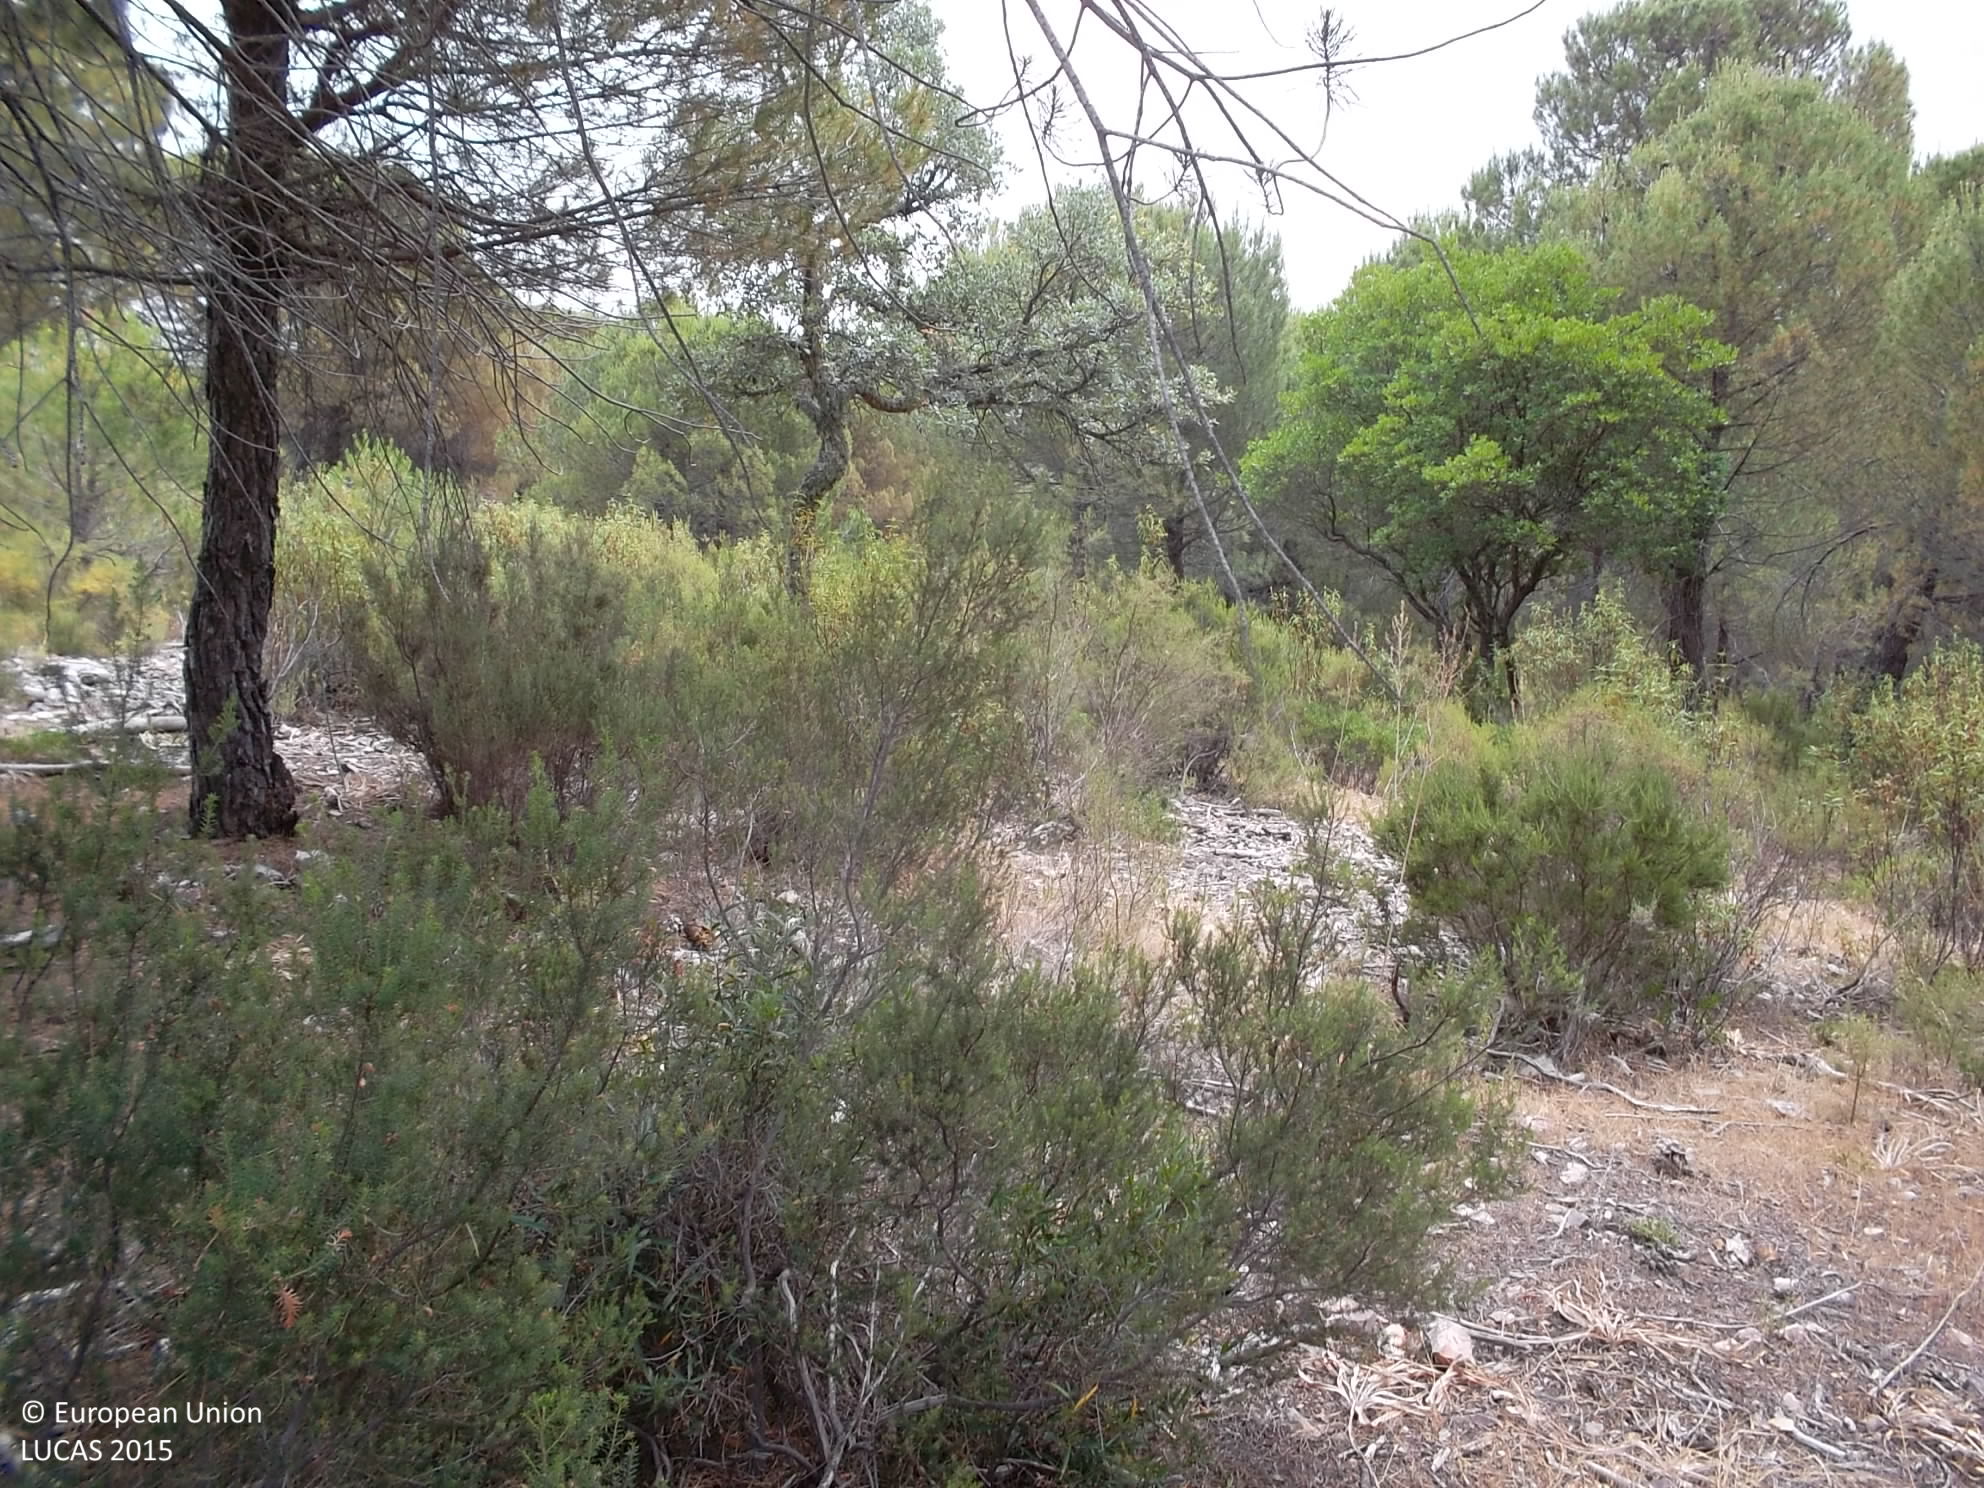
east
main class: Woodland
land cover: Pine dominated coniferous woodland
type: coniferous forest of the mediterranean region
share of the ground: > 75 %
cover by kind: coniferous forest trees 60 %, shrubs 30 %, herbaceous plants 10 %
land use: Forestry
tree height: > 5 m
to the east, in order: Pine dominated coniferous woodland; Tracks; Pine dominated coniferous woodland; Other structural elements; Pine dominated coniferous woodland
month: June
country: ES
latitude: 39.2998
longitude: -4.9400
